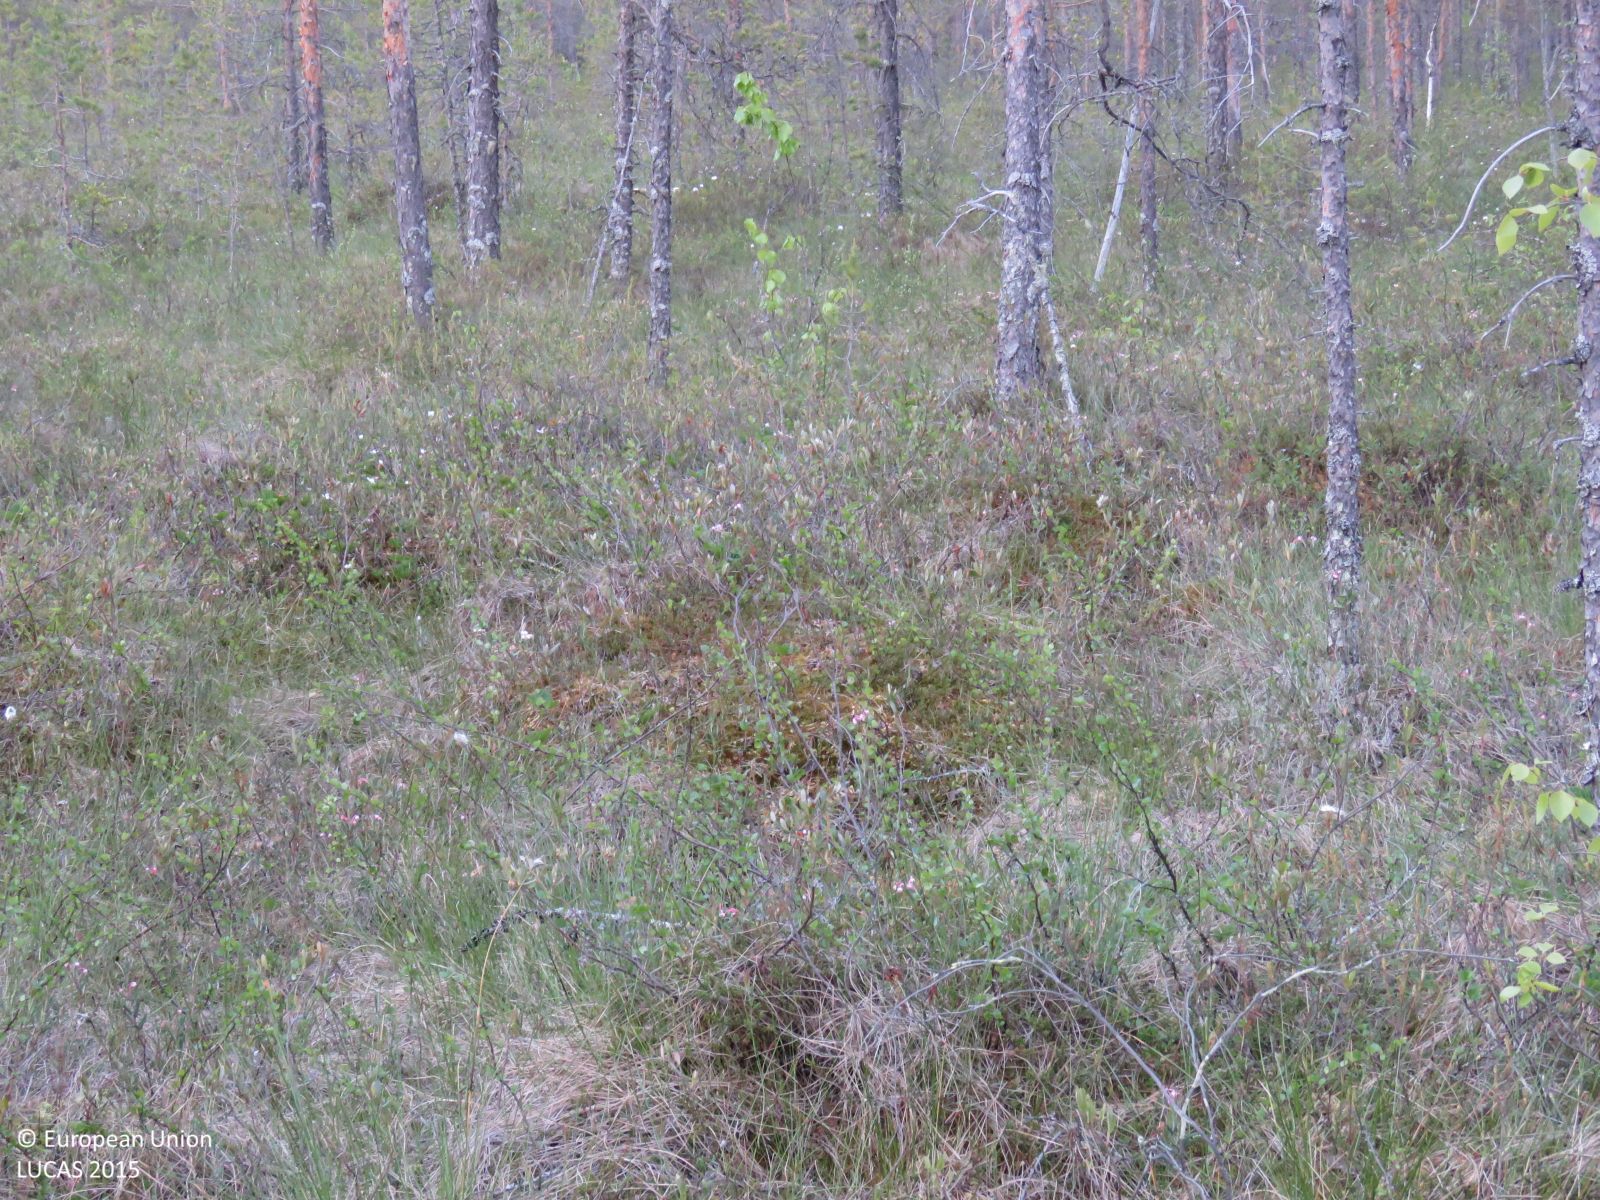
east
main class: Woodland
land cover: Pine dominated coniferous woodland
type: mire and swamp forests
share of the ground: 25 - 50 %
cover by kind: shrubs 55 %, coniferous forest trees 30 %, broadleaved forest trees 5 %, herbaceous plants 5 %, lichens and mosses 5 %
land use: Forestry
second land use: Amenities, museums, leisure
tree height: > 5 m
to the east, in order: Pine dominated coniferous woodland; Other mixed woodland; Ditches and canals; Other coniferous woodland; Ditches and canals; Other mixed woodland; Ditches and canals; Other mixed woodland
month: June
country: FI
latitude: 64.8076
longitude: 26.2969
